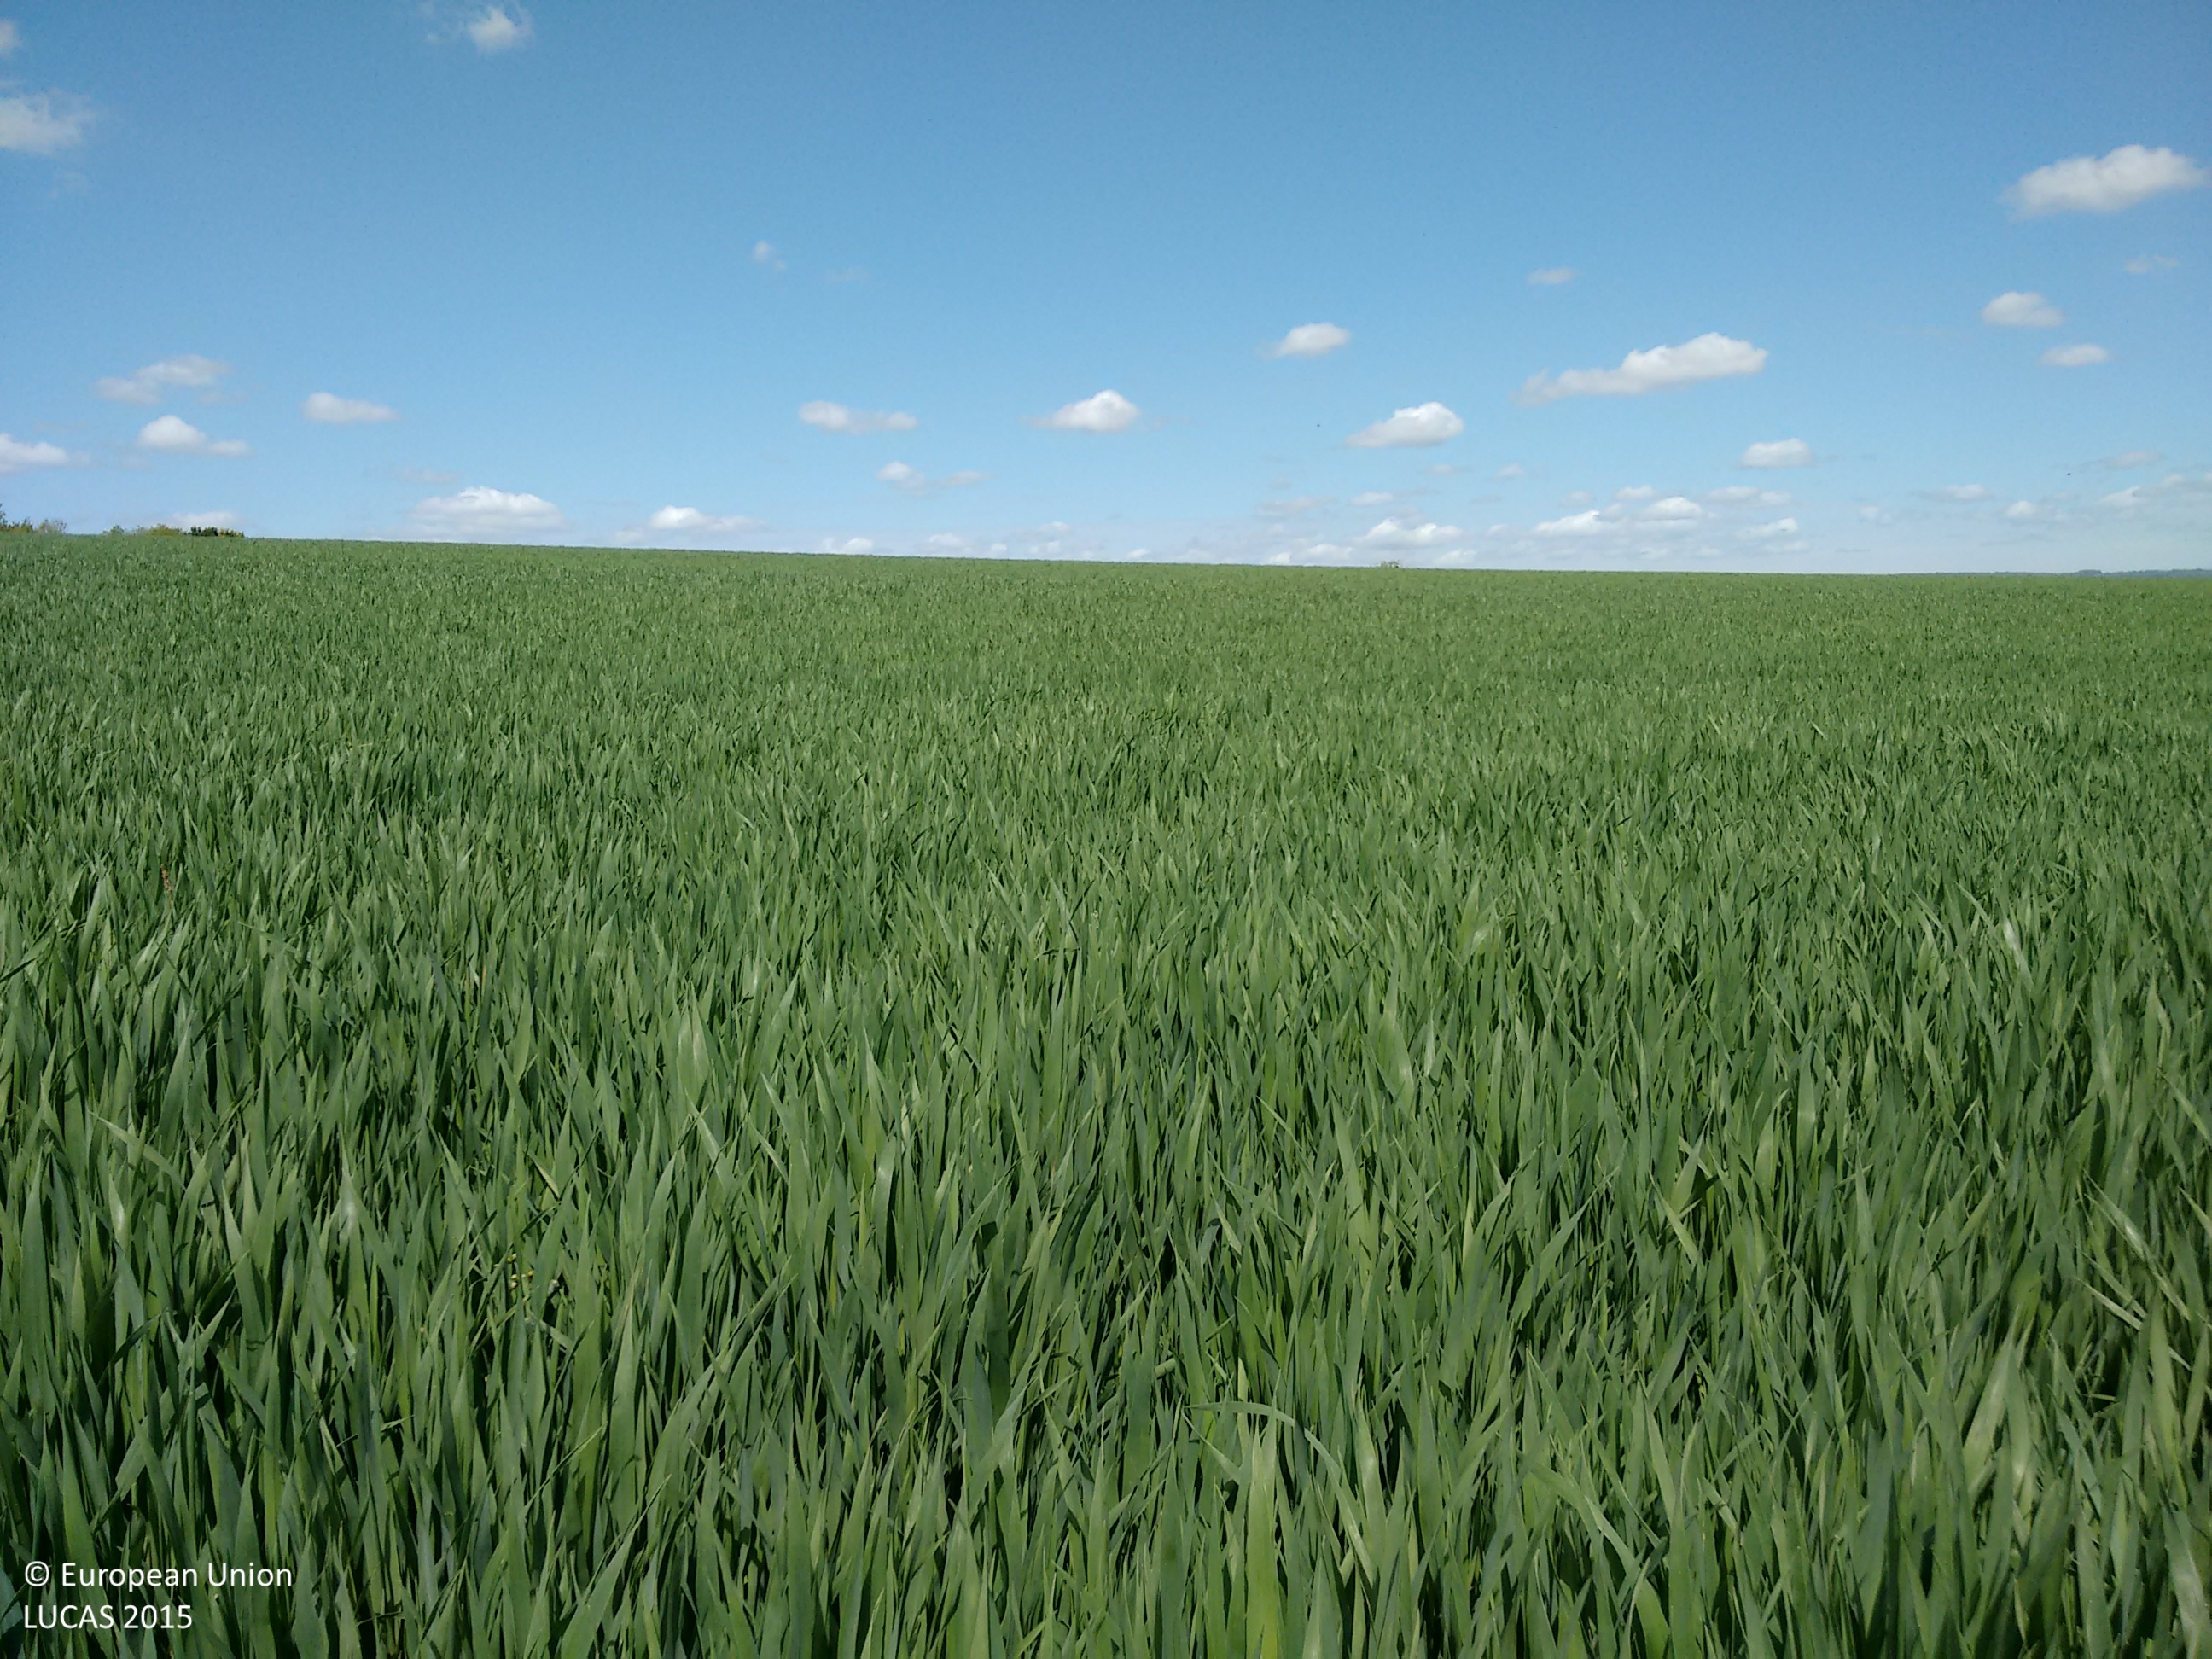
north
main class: Cropland
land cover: Common wheat
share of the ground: > 75 %
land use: Agriculture (excluding fallow land and kitchen gardens)
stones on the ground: > 50 %
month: May
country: GB
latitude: 50.9036
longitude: -2.0755
